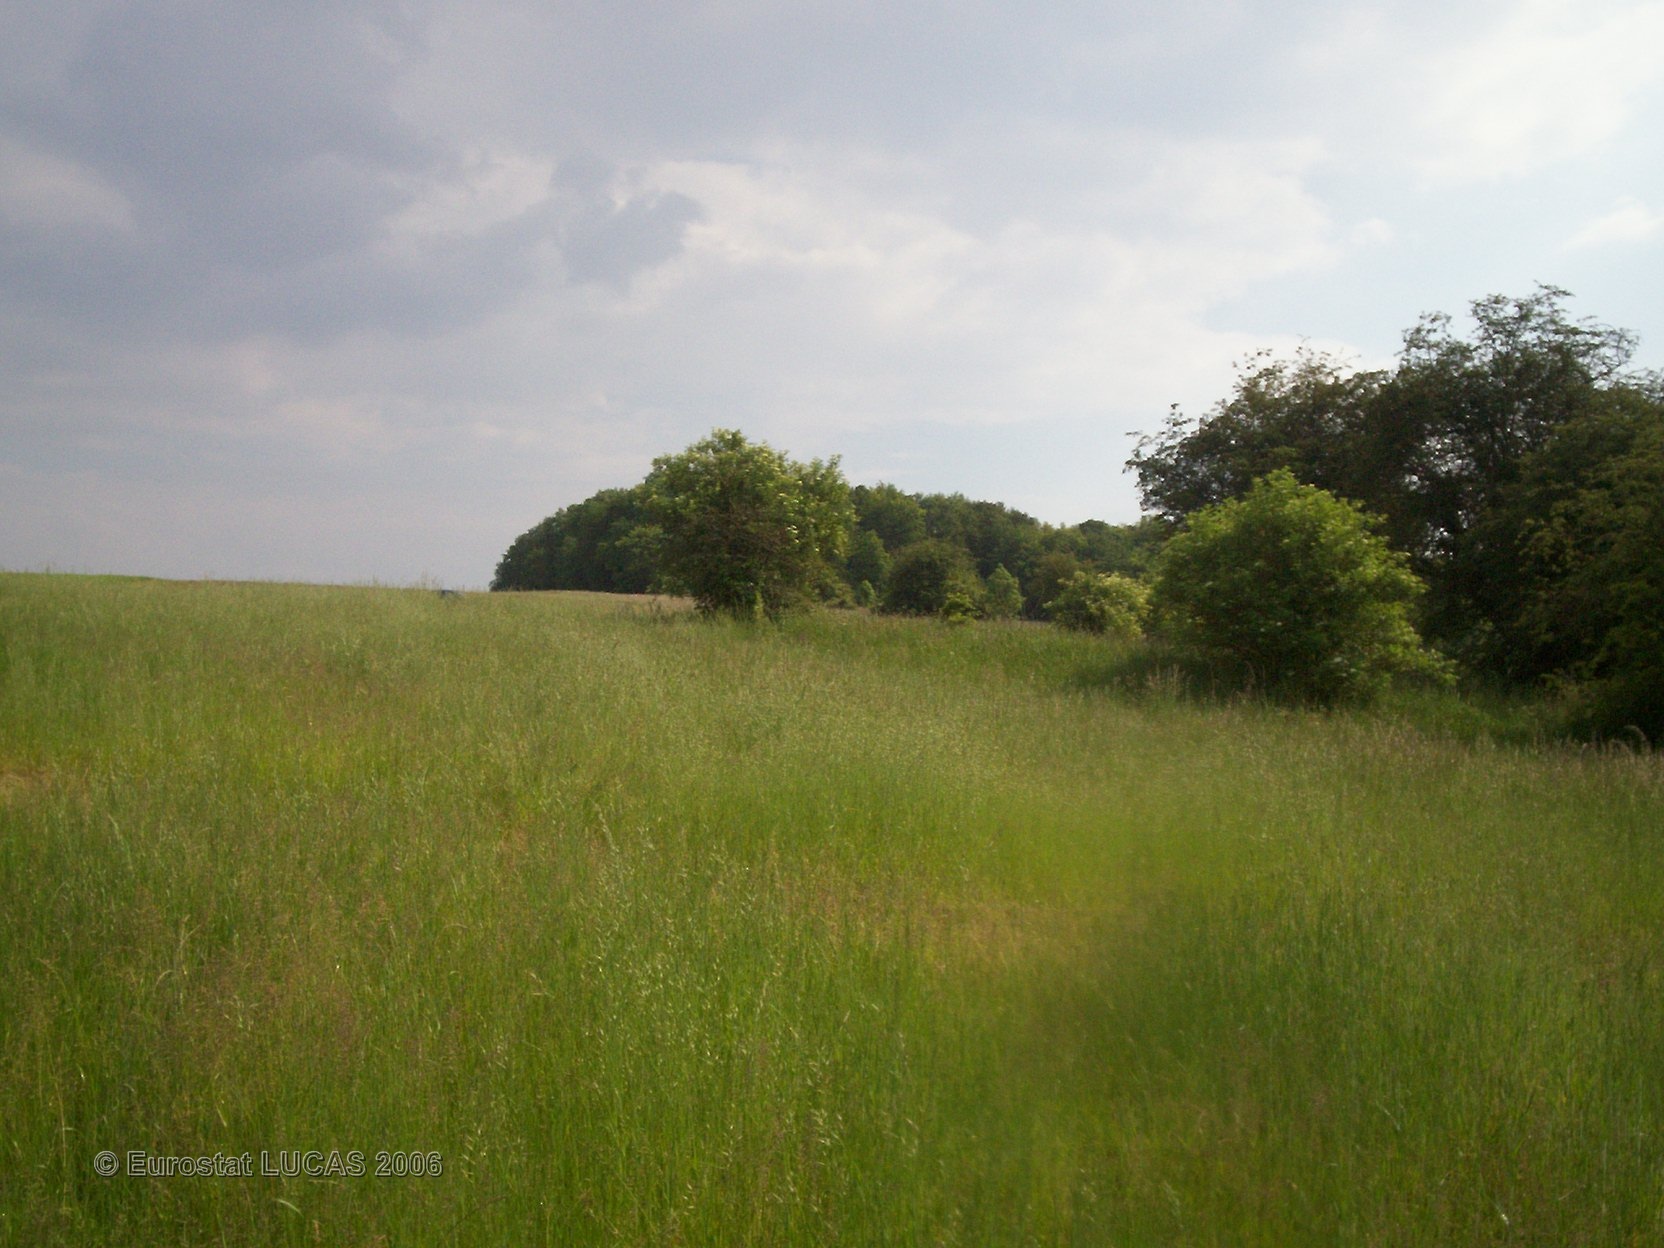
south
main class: Grassland
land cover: Grassland without tree/shrub cover
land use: Agriculture (excluding fallow land and kitchen gardens)
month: June
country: FR
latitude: 49.6962
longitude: 2.6827
